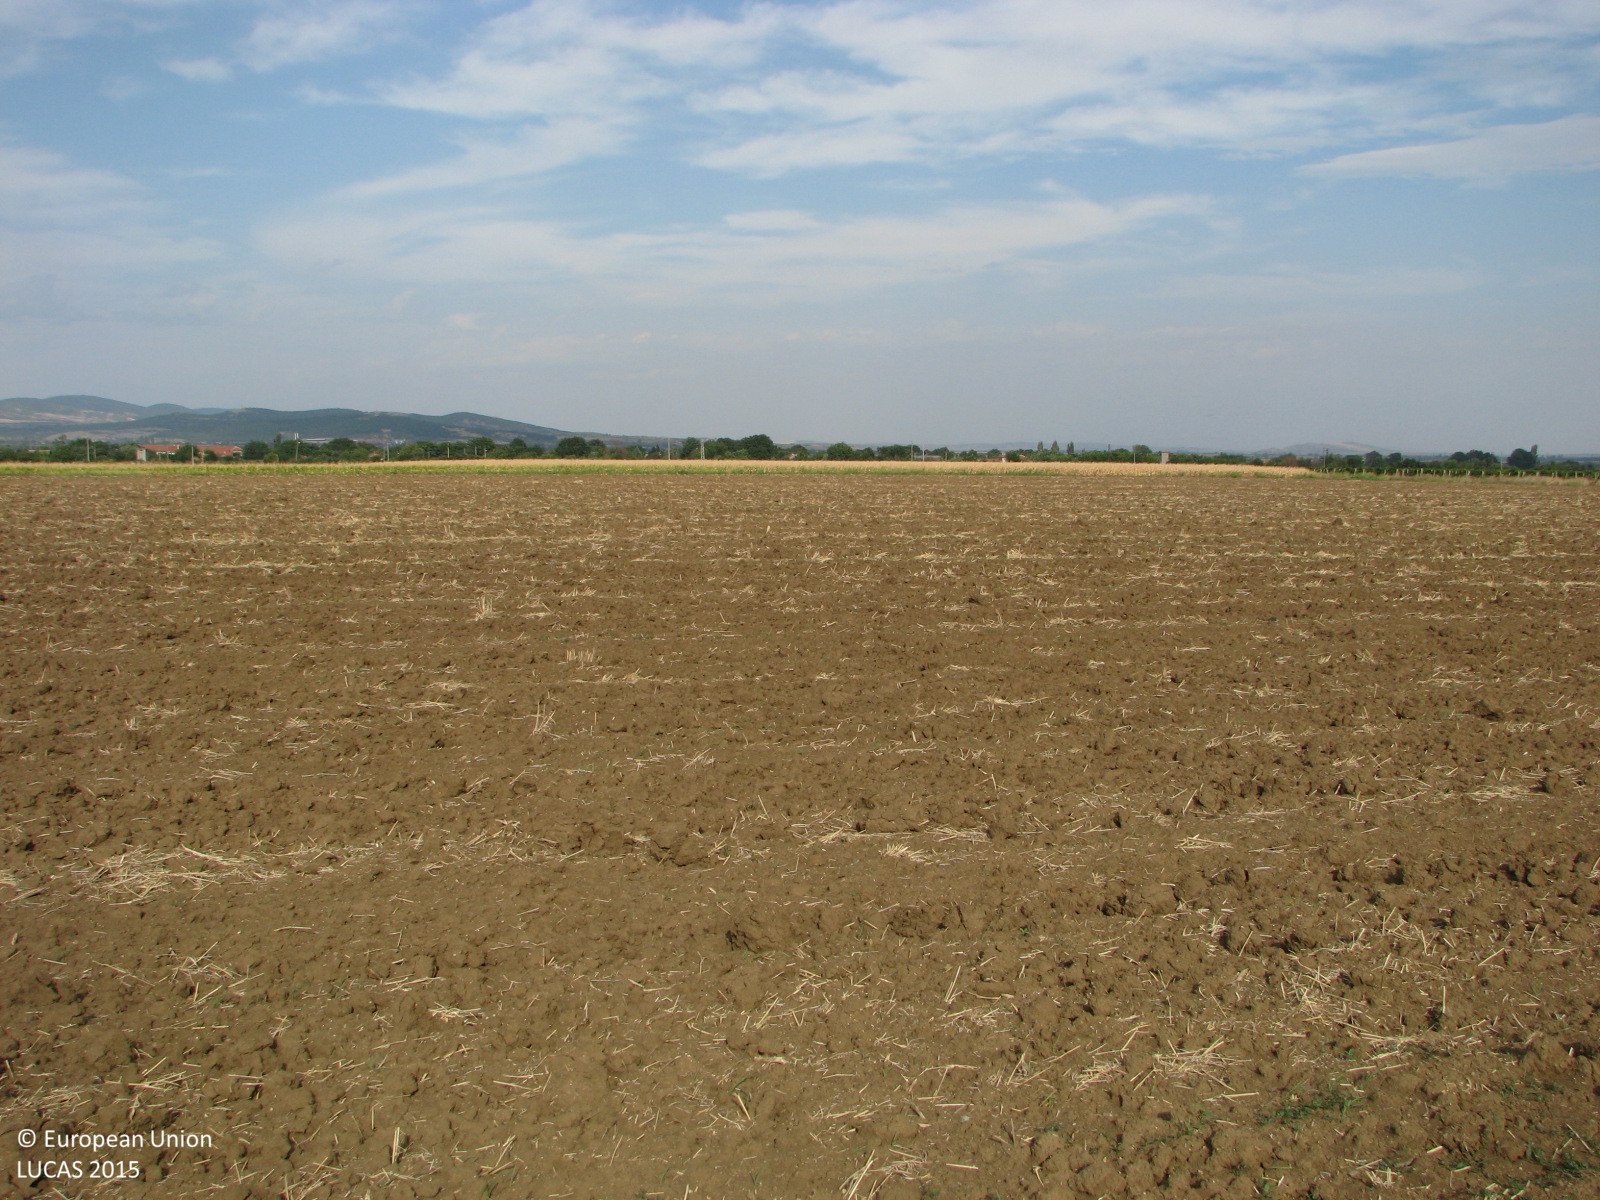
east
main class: Cropland
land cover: Maize
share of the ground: > 75 %
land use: Agriculture (excluding fallow land and kitchen gardens)
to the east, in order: Maize; Abandoned hedges; Inland fresh running water; Abandoned hedges; Grass margins; Tracks; Grass margins; Other bare soil
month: September
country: BG
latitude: 42.5211
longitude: 25.9407
